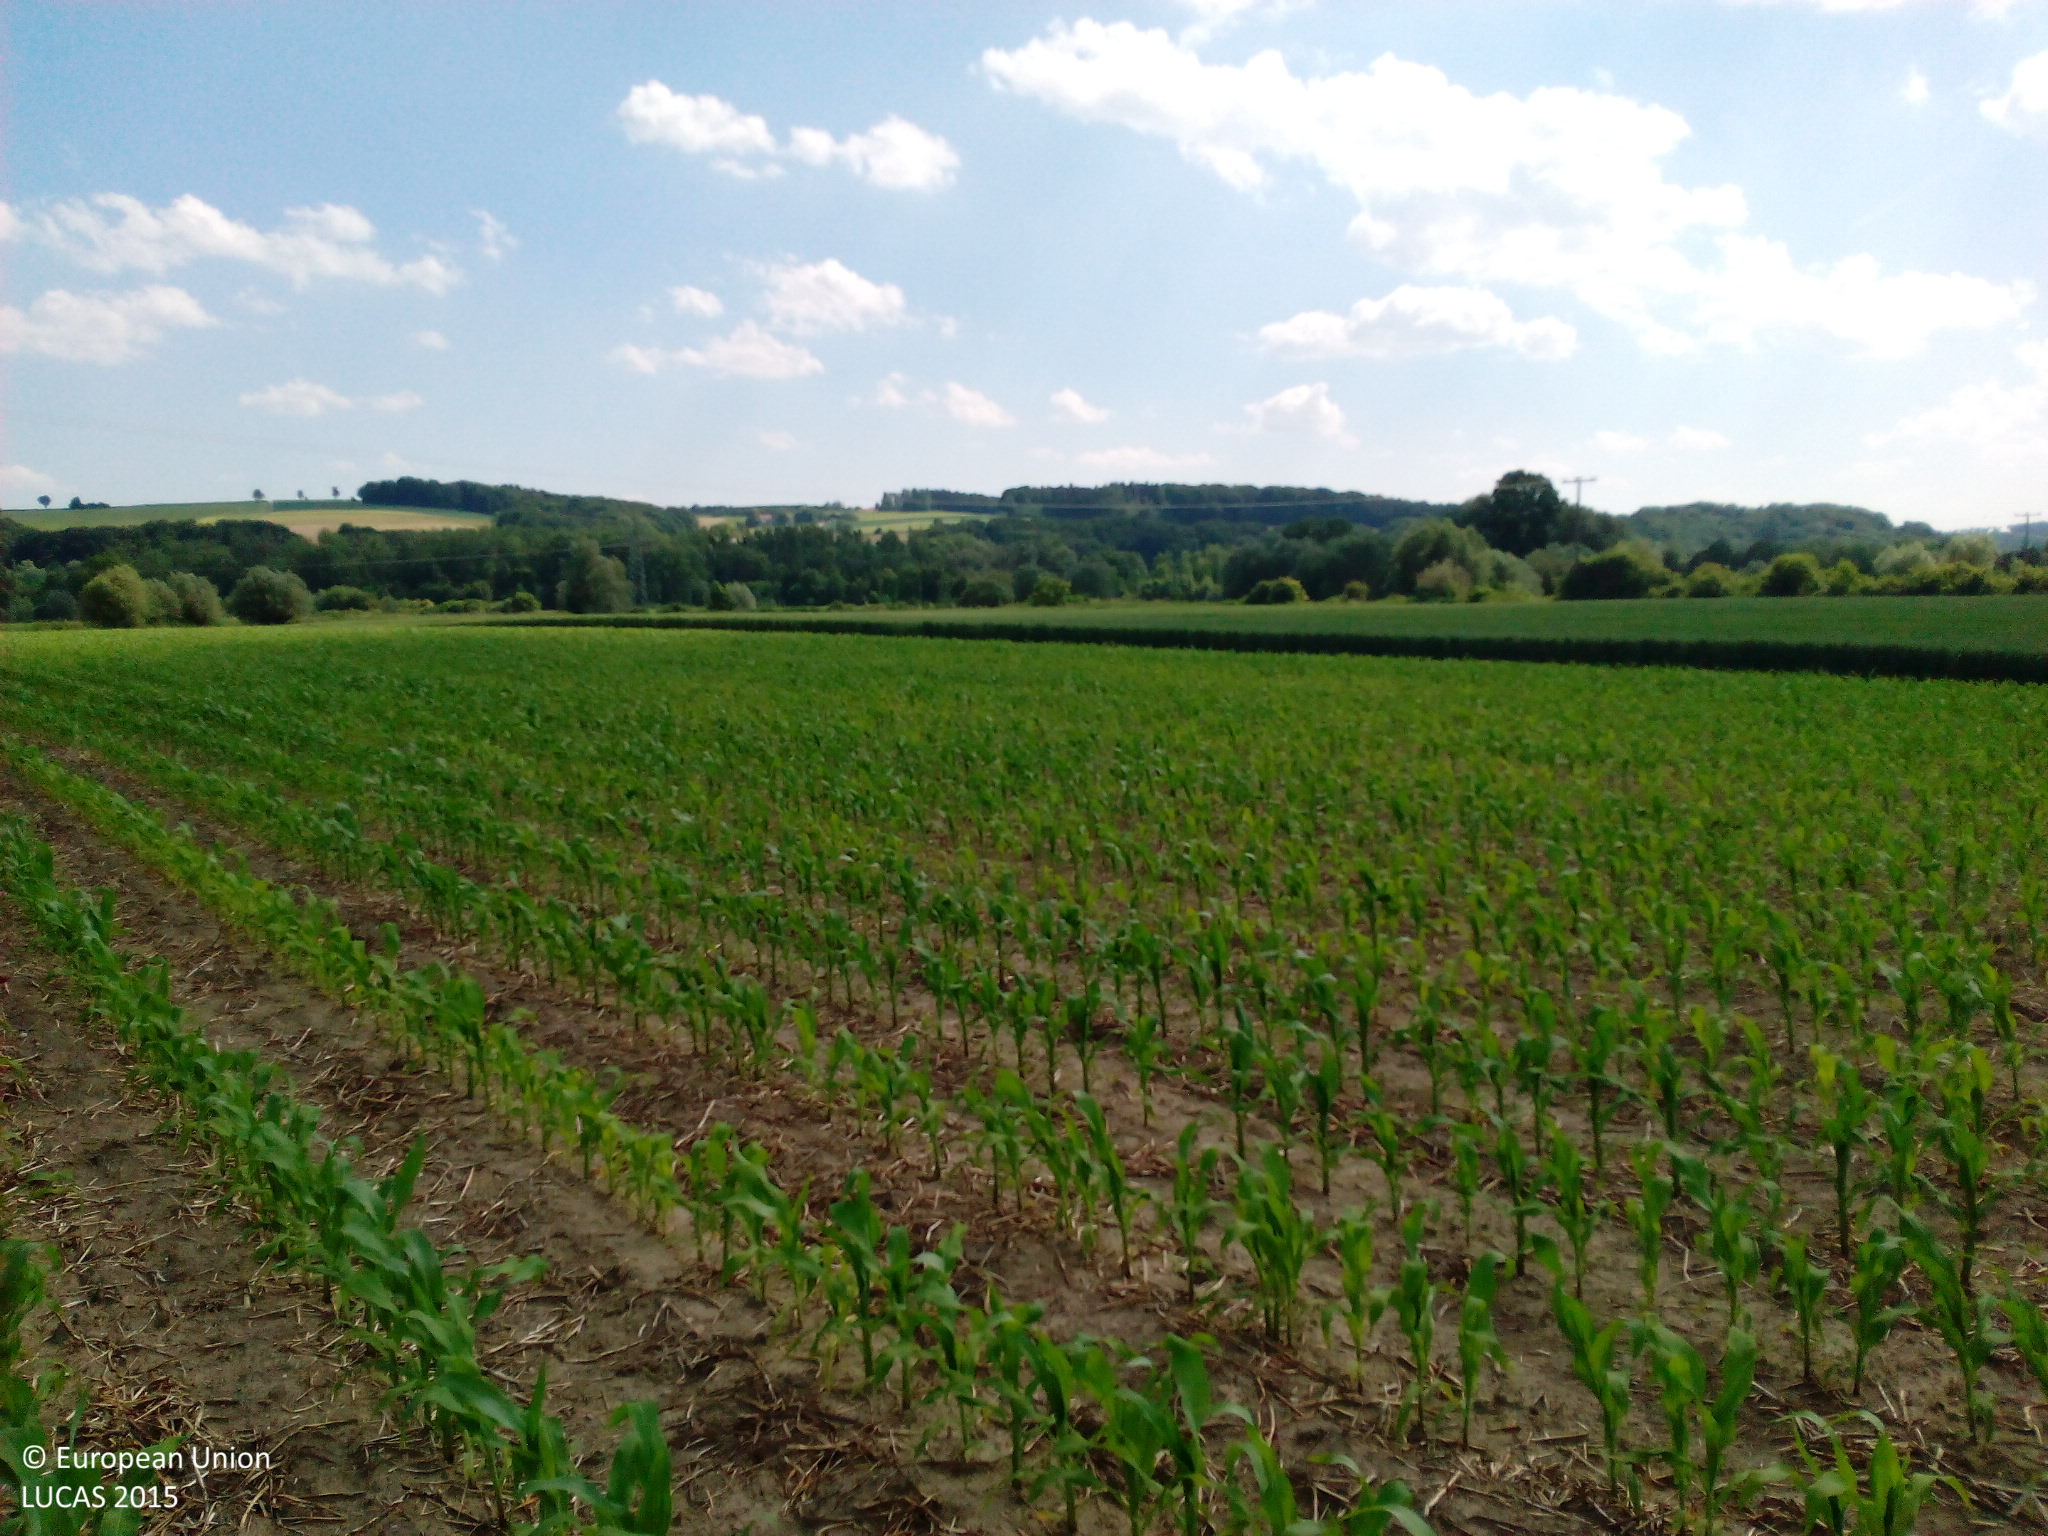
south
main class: Cropland
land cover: Maize
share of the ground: 25 - 50 %
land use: Agriculture (excluding fallow land and kitchen gardens)
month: June
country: DE
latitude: 48.6294
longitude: 12.4008
